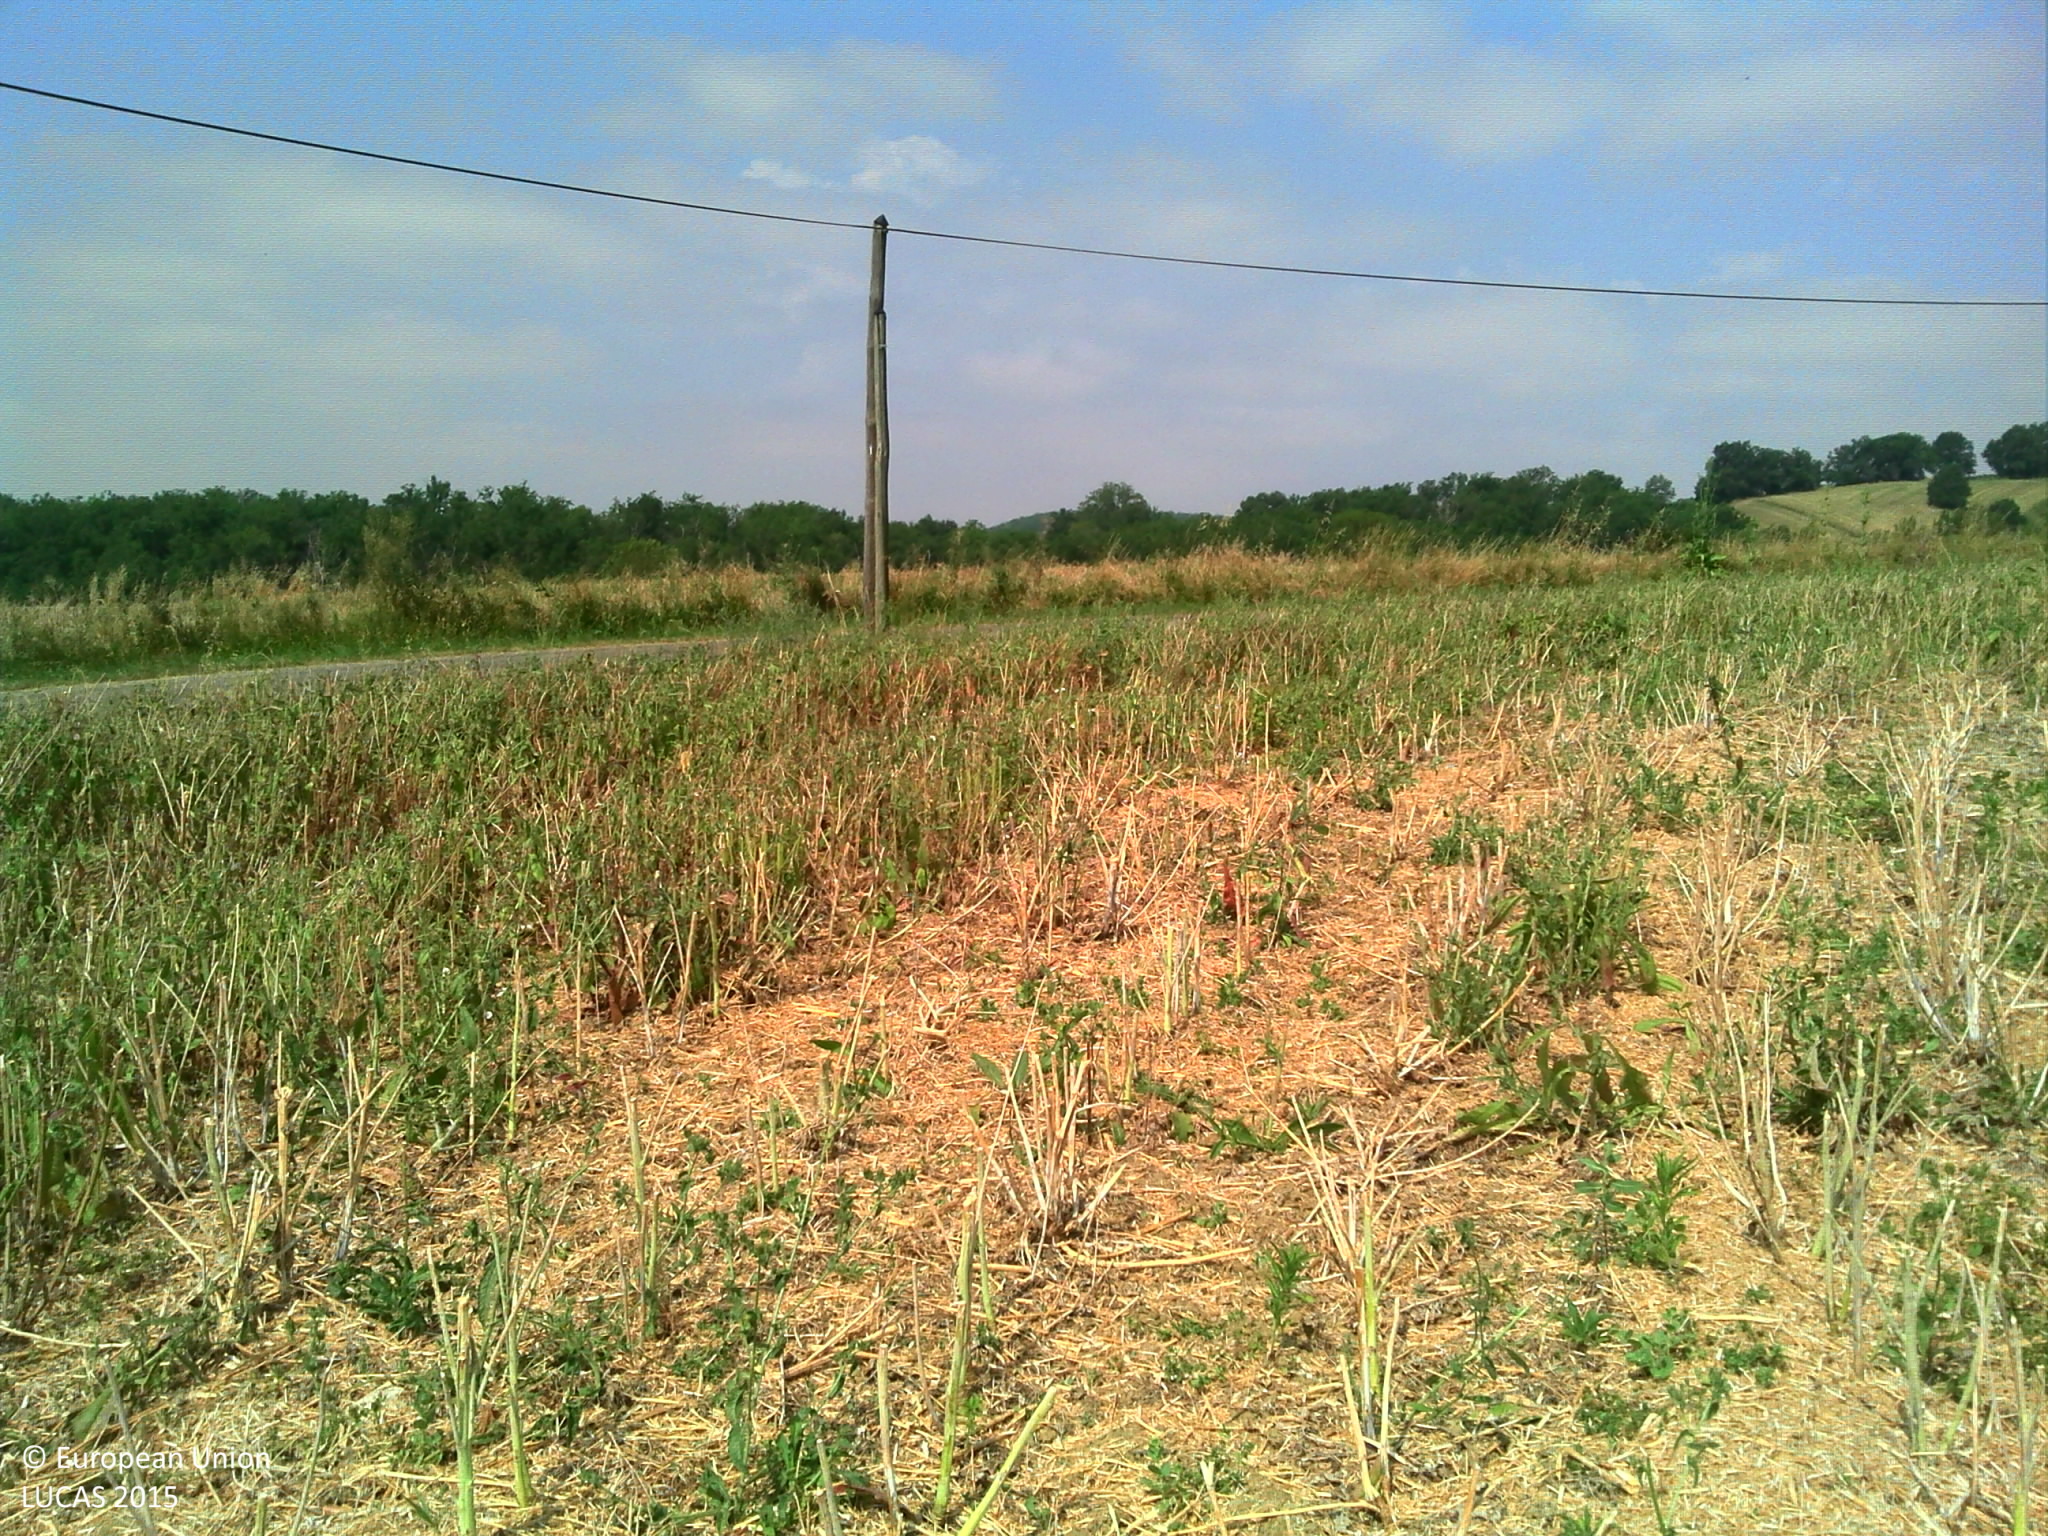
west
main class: Cropland
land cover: Rape and turnip rape
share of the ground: 10 - 25 %
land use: Agriculture (excluding fallow land and kitchen gardens)
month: July
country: FR
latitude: 44.2933
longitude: 0.8845
